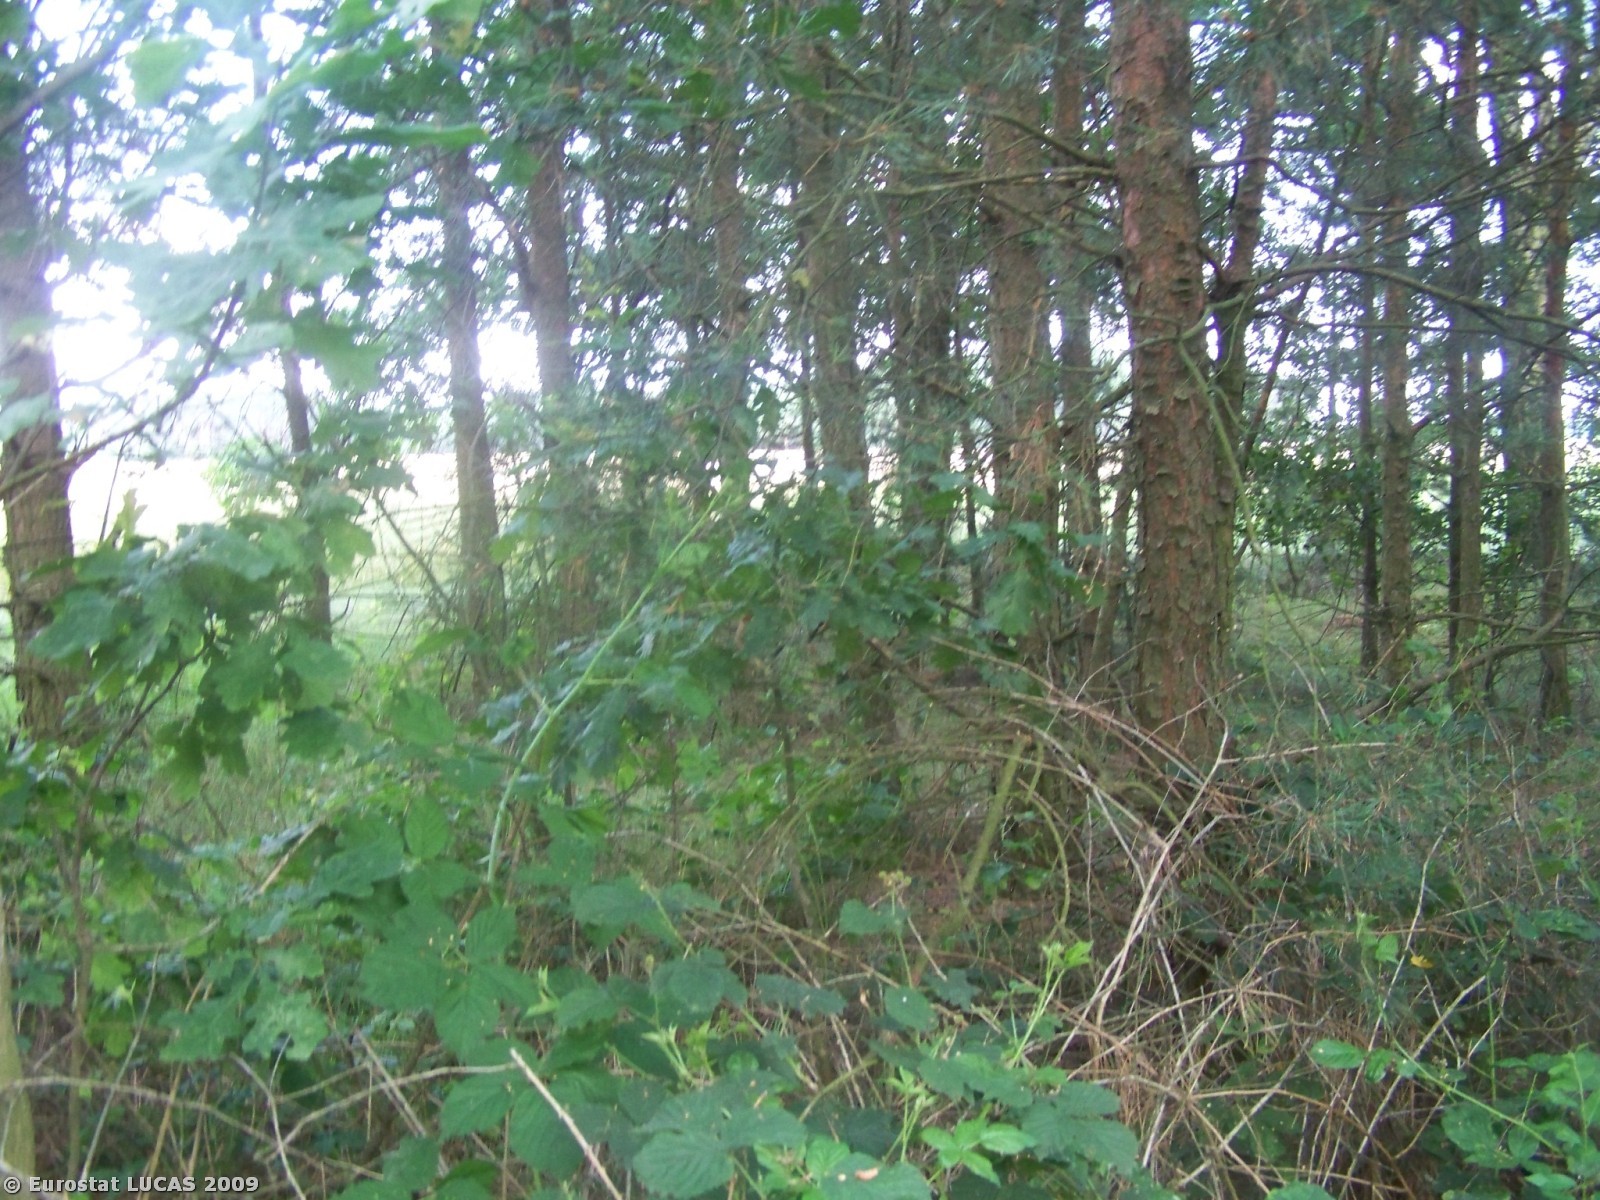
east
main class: Woodland
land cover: Coniferous woodland
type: hemiboreal forest and nemoral coniferous forest and mixed broadleaved-coniferous forest
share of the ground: > 75 %
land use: Forestry
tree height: > 5 m
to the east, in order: Coniferous woodland; Mixed cereals for fodder; Tracks; Rye; Grass margins; Rye; Grass margins; Rye; Tracks; Mixed cereals for fodder; Grass margins; Rye
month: July
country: PL
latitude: 52.0236
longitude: 21.6095
